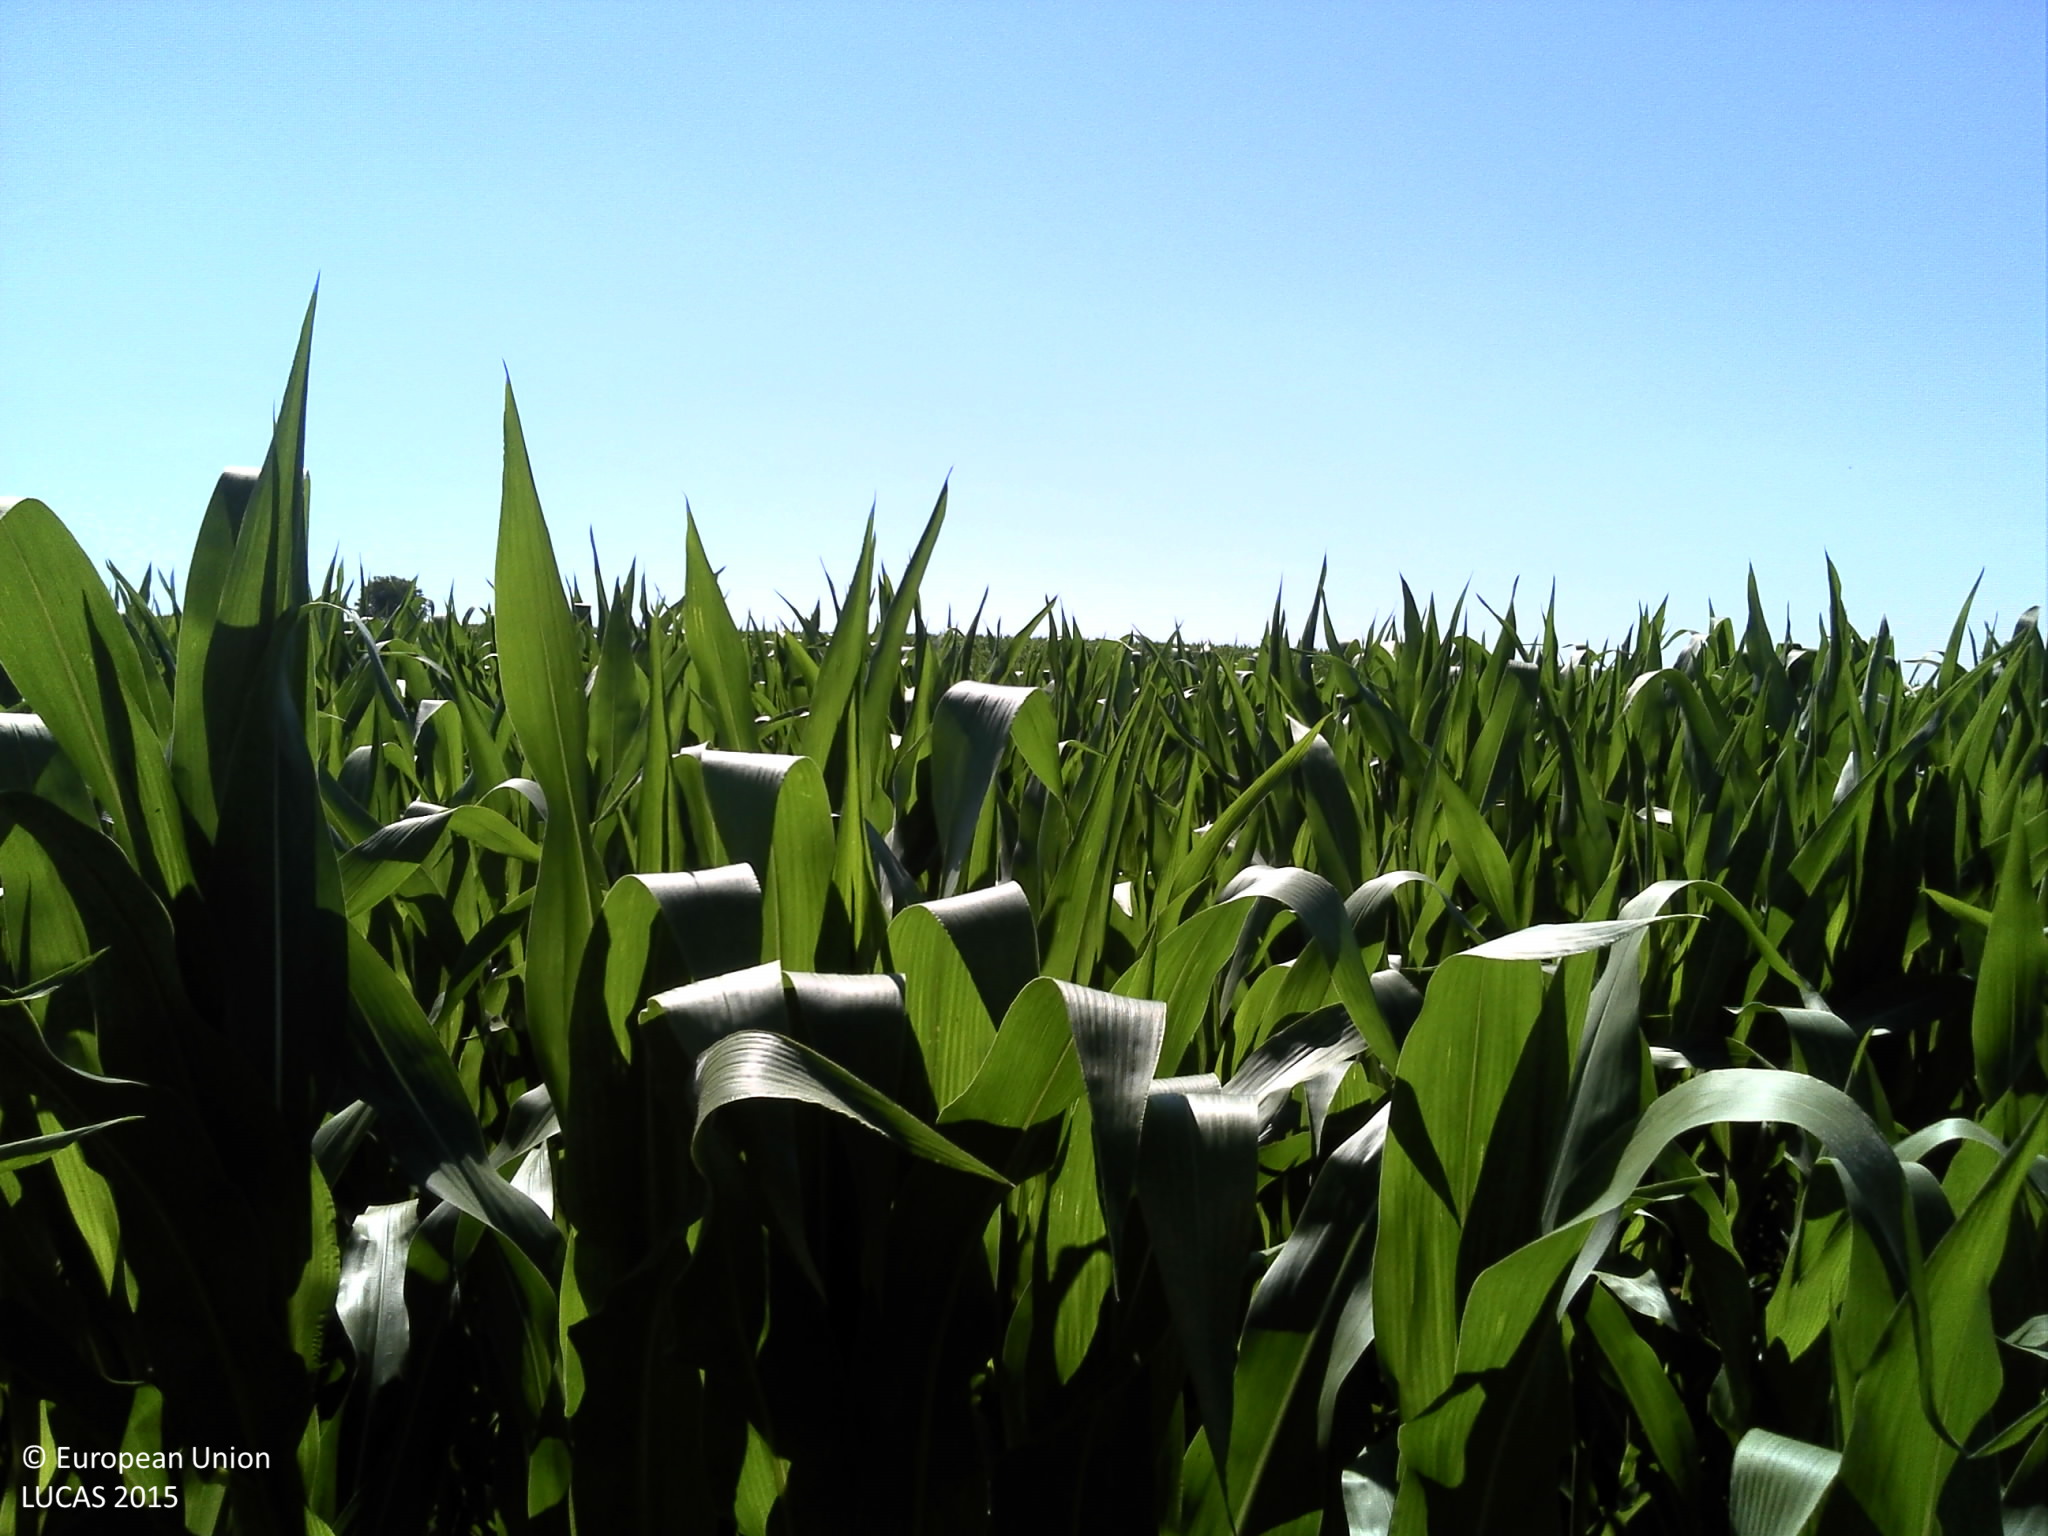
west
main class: Cropland
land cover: Maize
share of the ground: > 75 %
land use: Agriculture (excluding fallow land and kitchen gardens)
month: July
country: FR
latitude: 49.5065
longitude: 4.7907
